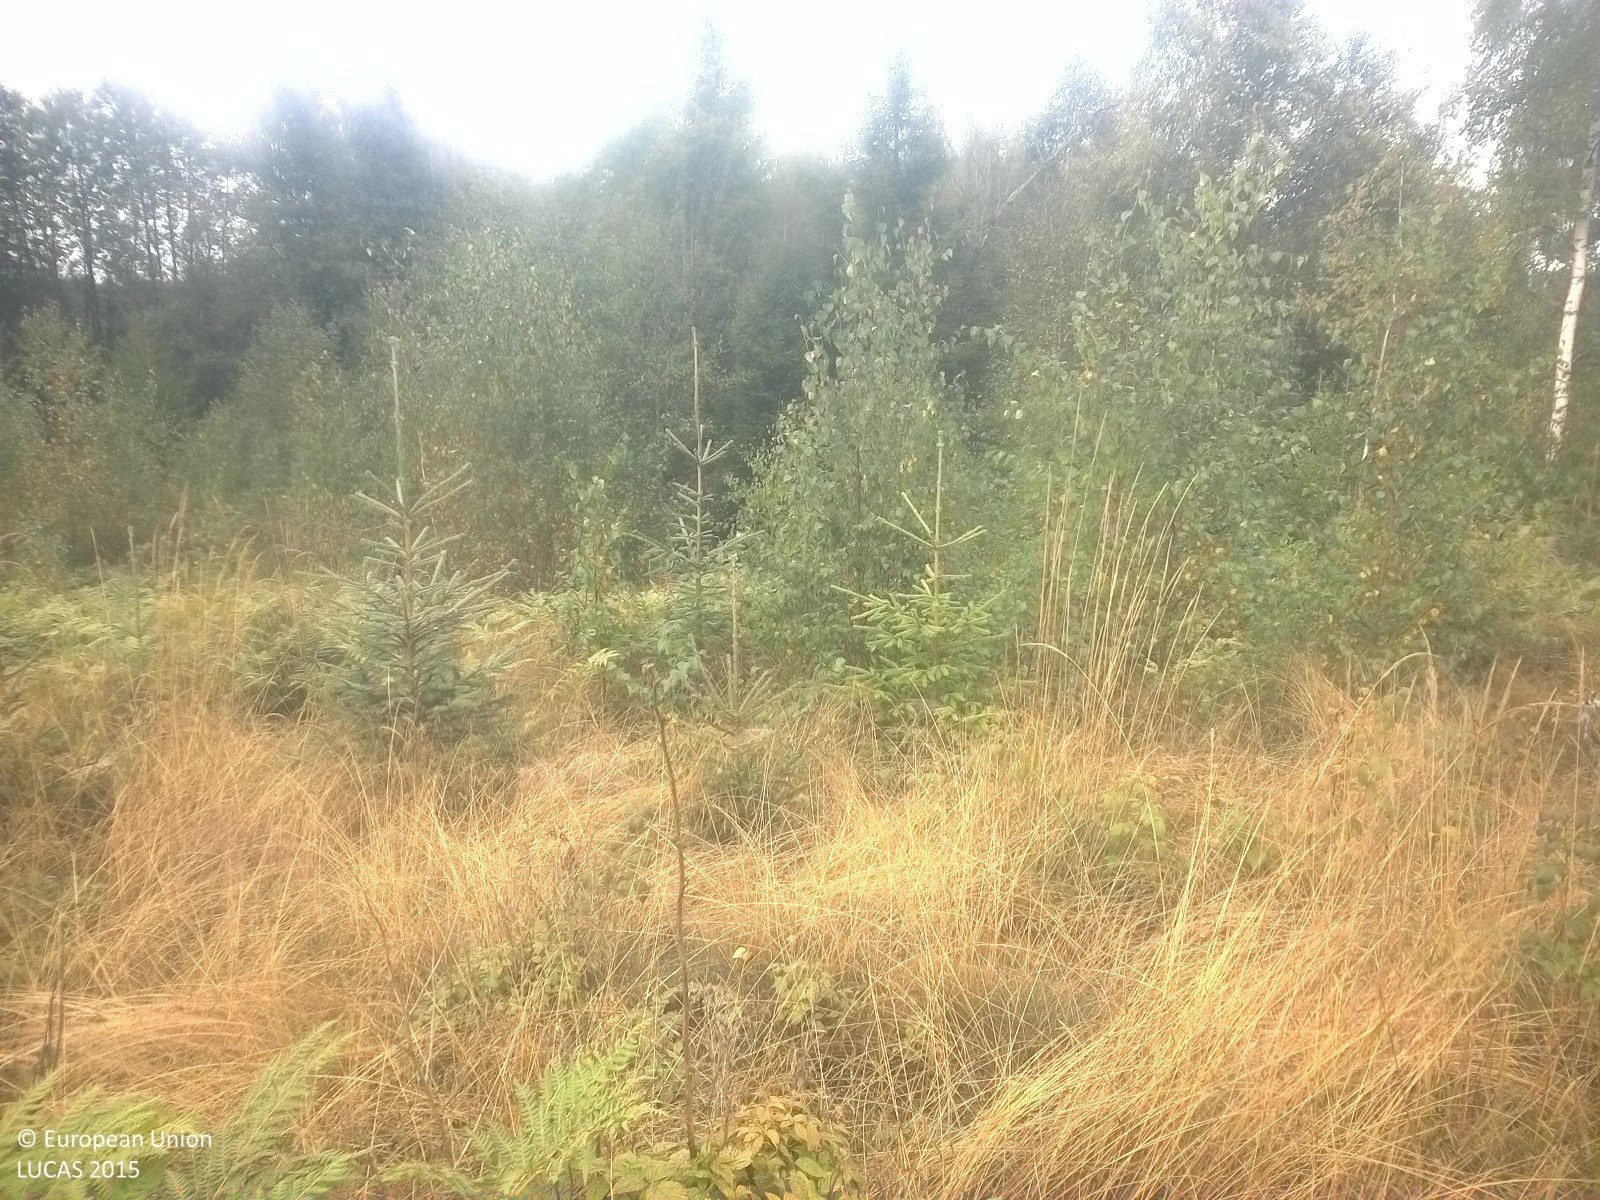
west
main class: Woodland
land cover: Spruce dominated mixed woodland
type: boreal forest
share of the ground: 25 - 50 %
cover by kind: herbaceous plants 35 %, coniferous forest trees 20 %, broadleaved forest trees 20 %, shrubs 10 %, lichens and mosses 10 %, consolidated bare surface 5 %
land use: Forestry
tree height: < 5 m
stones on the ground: 25 - 50 %
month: September
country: SE
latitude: 59.3626
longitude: 15.6742
